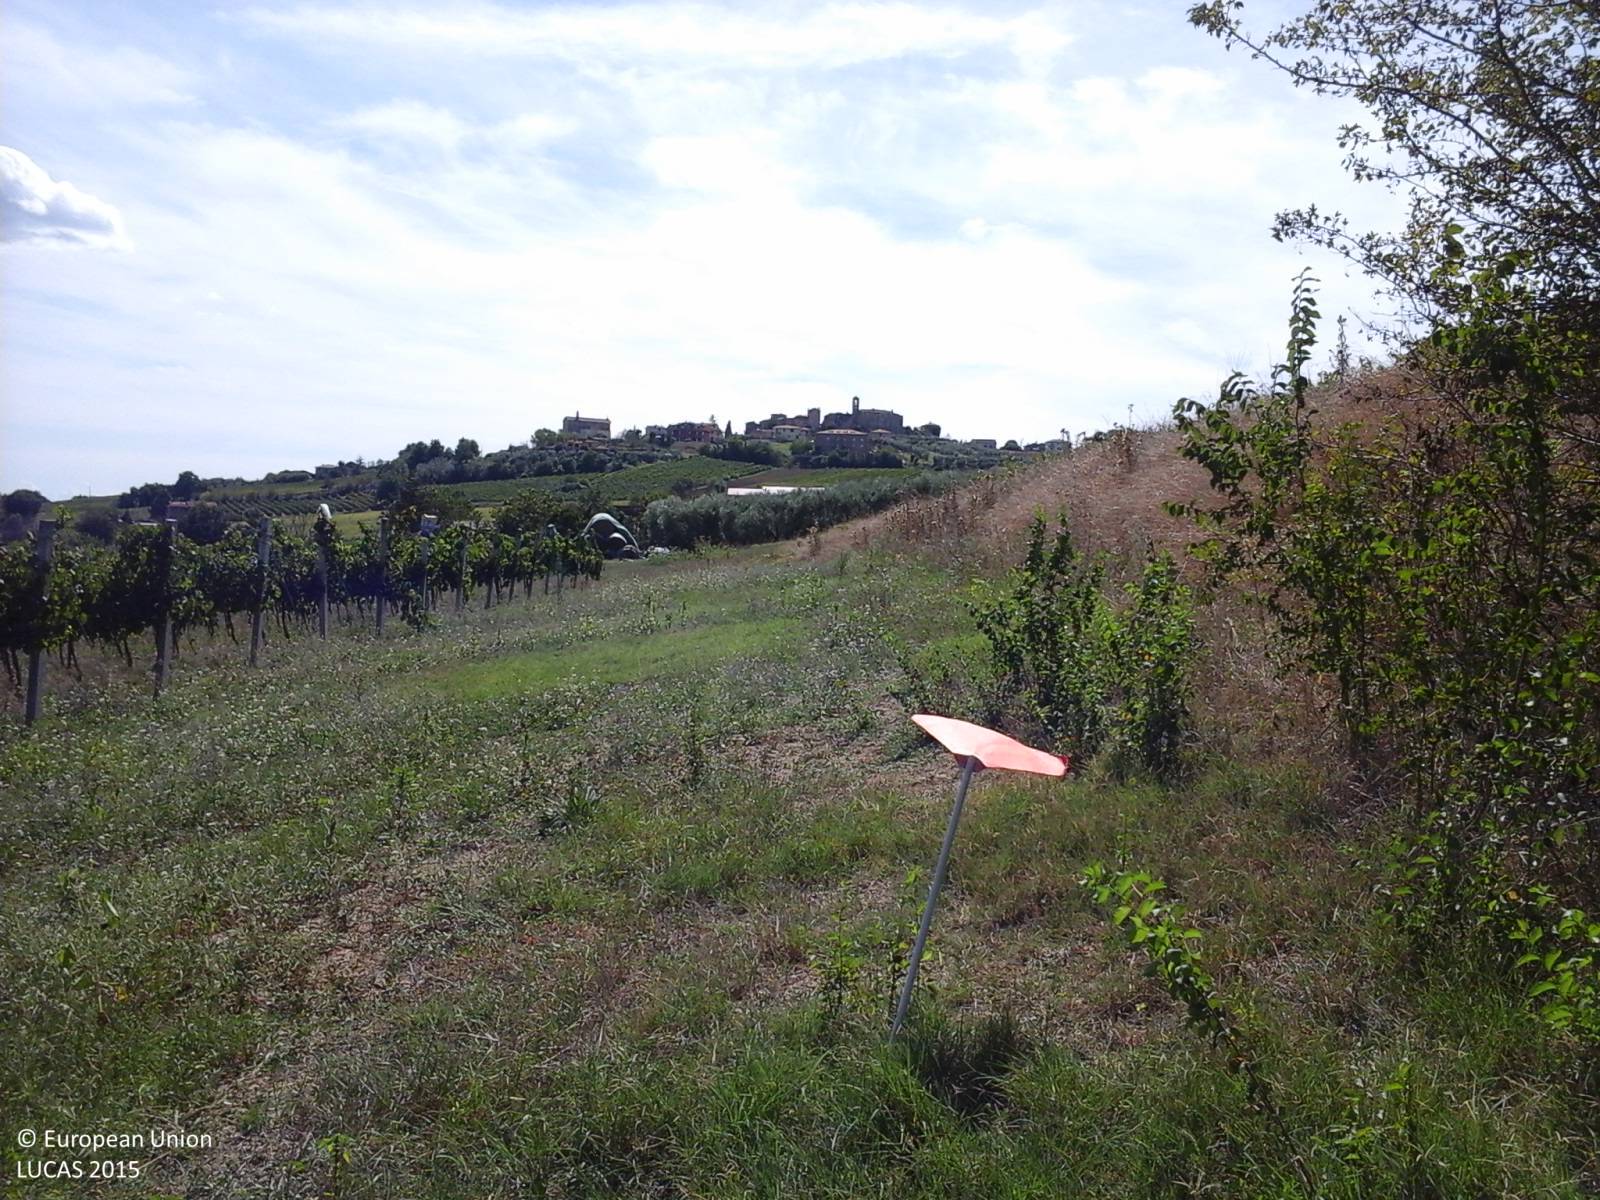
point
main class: Grassland
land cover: Grassland without tree/shrub cover
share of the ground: 25 - 50 %
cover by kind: herbaceous plants 100 %
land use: Agriculture (excluding fallow land and kitchen gardens)
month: September
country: IT
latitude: 42.9878
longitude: 12.3600
